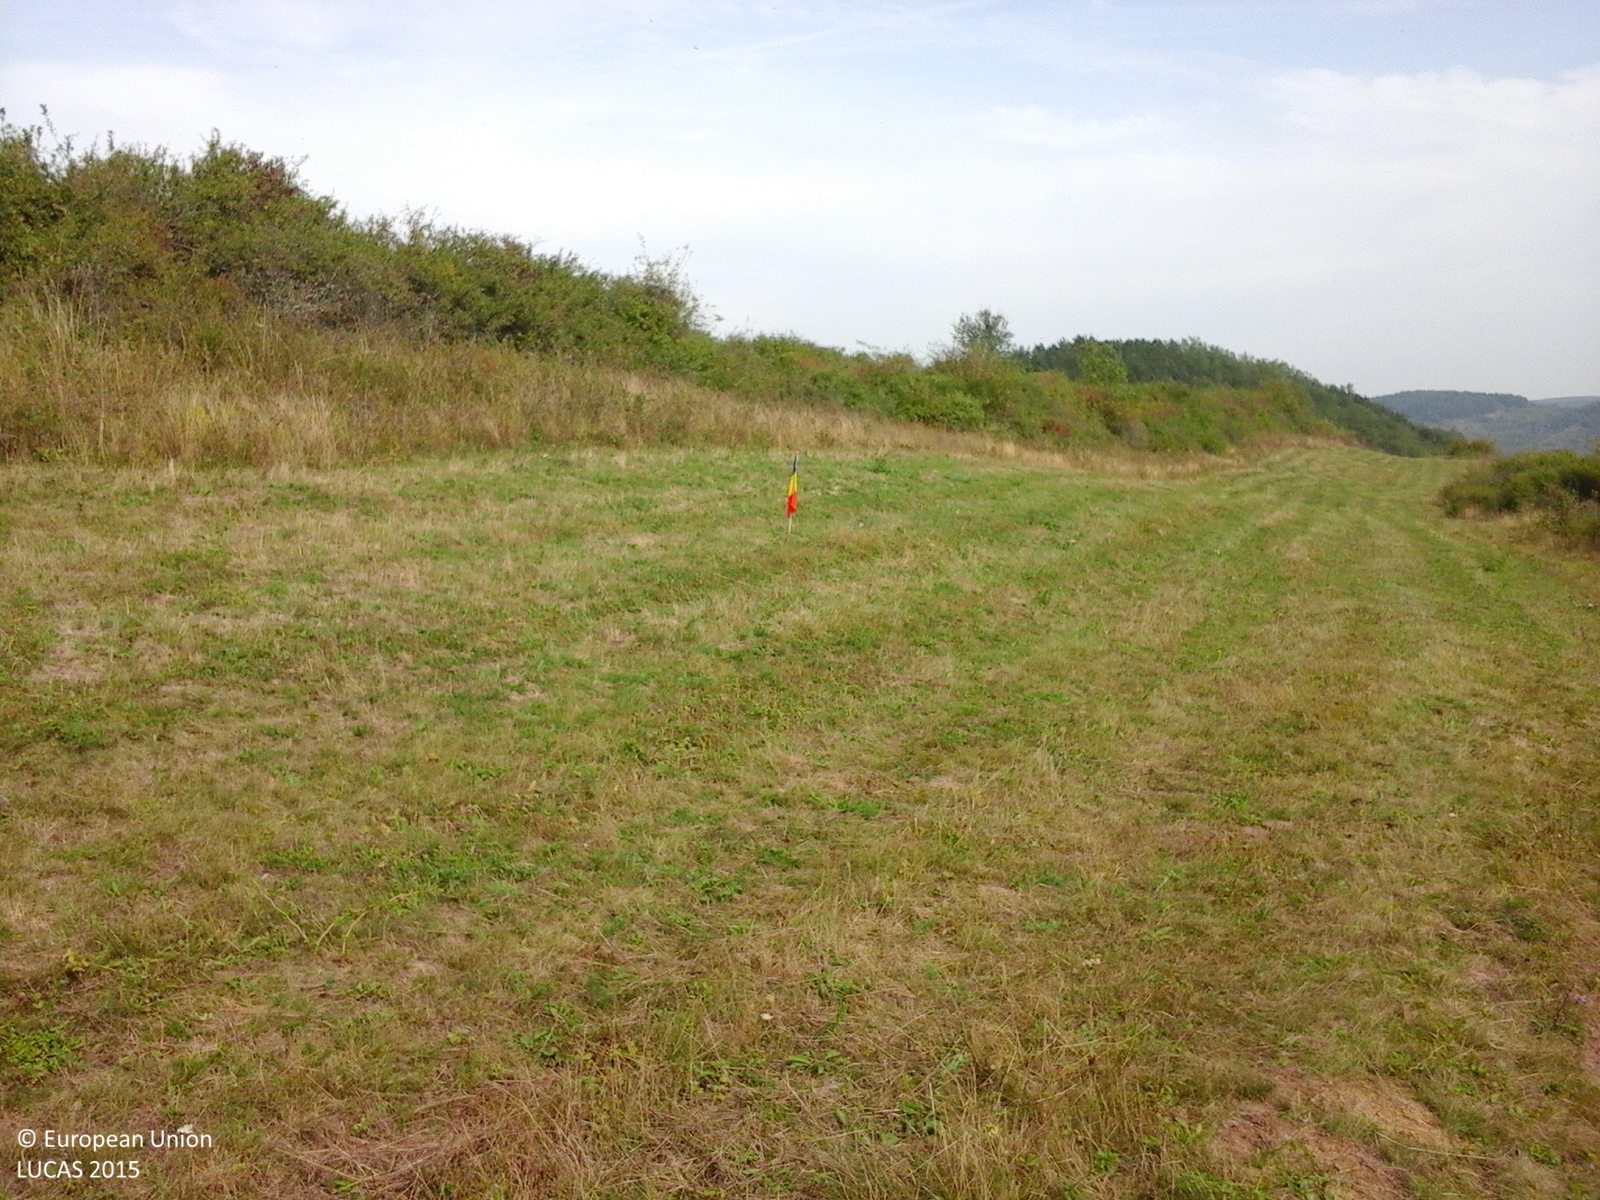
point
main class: Grassland
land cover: Grassland without tree/shrub cover
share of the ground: > 75 %
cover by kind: herbaceous plants 100 %
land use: Agriculture (excluding fallow land and kitchen gardens)
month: September
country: RO
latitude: 47.1335
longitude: 23.6405
